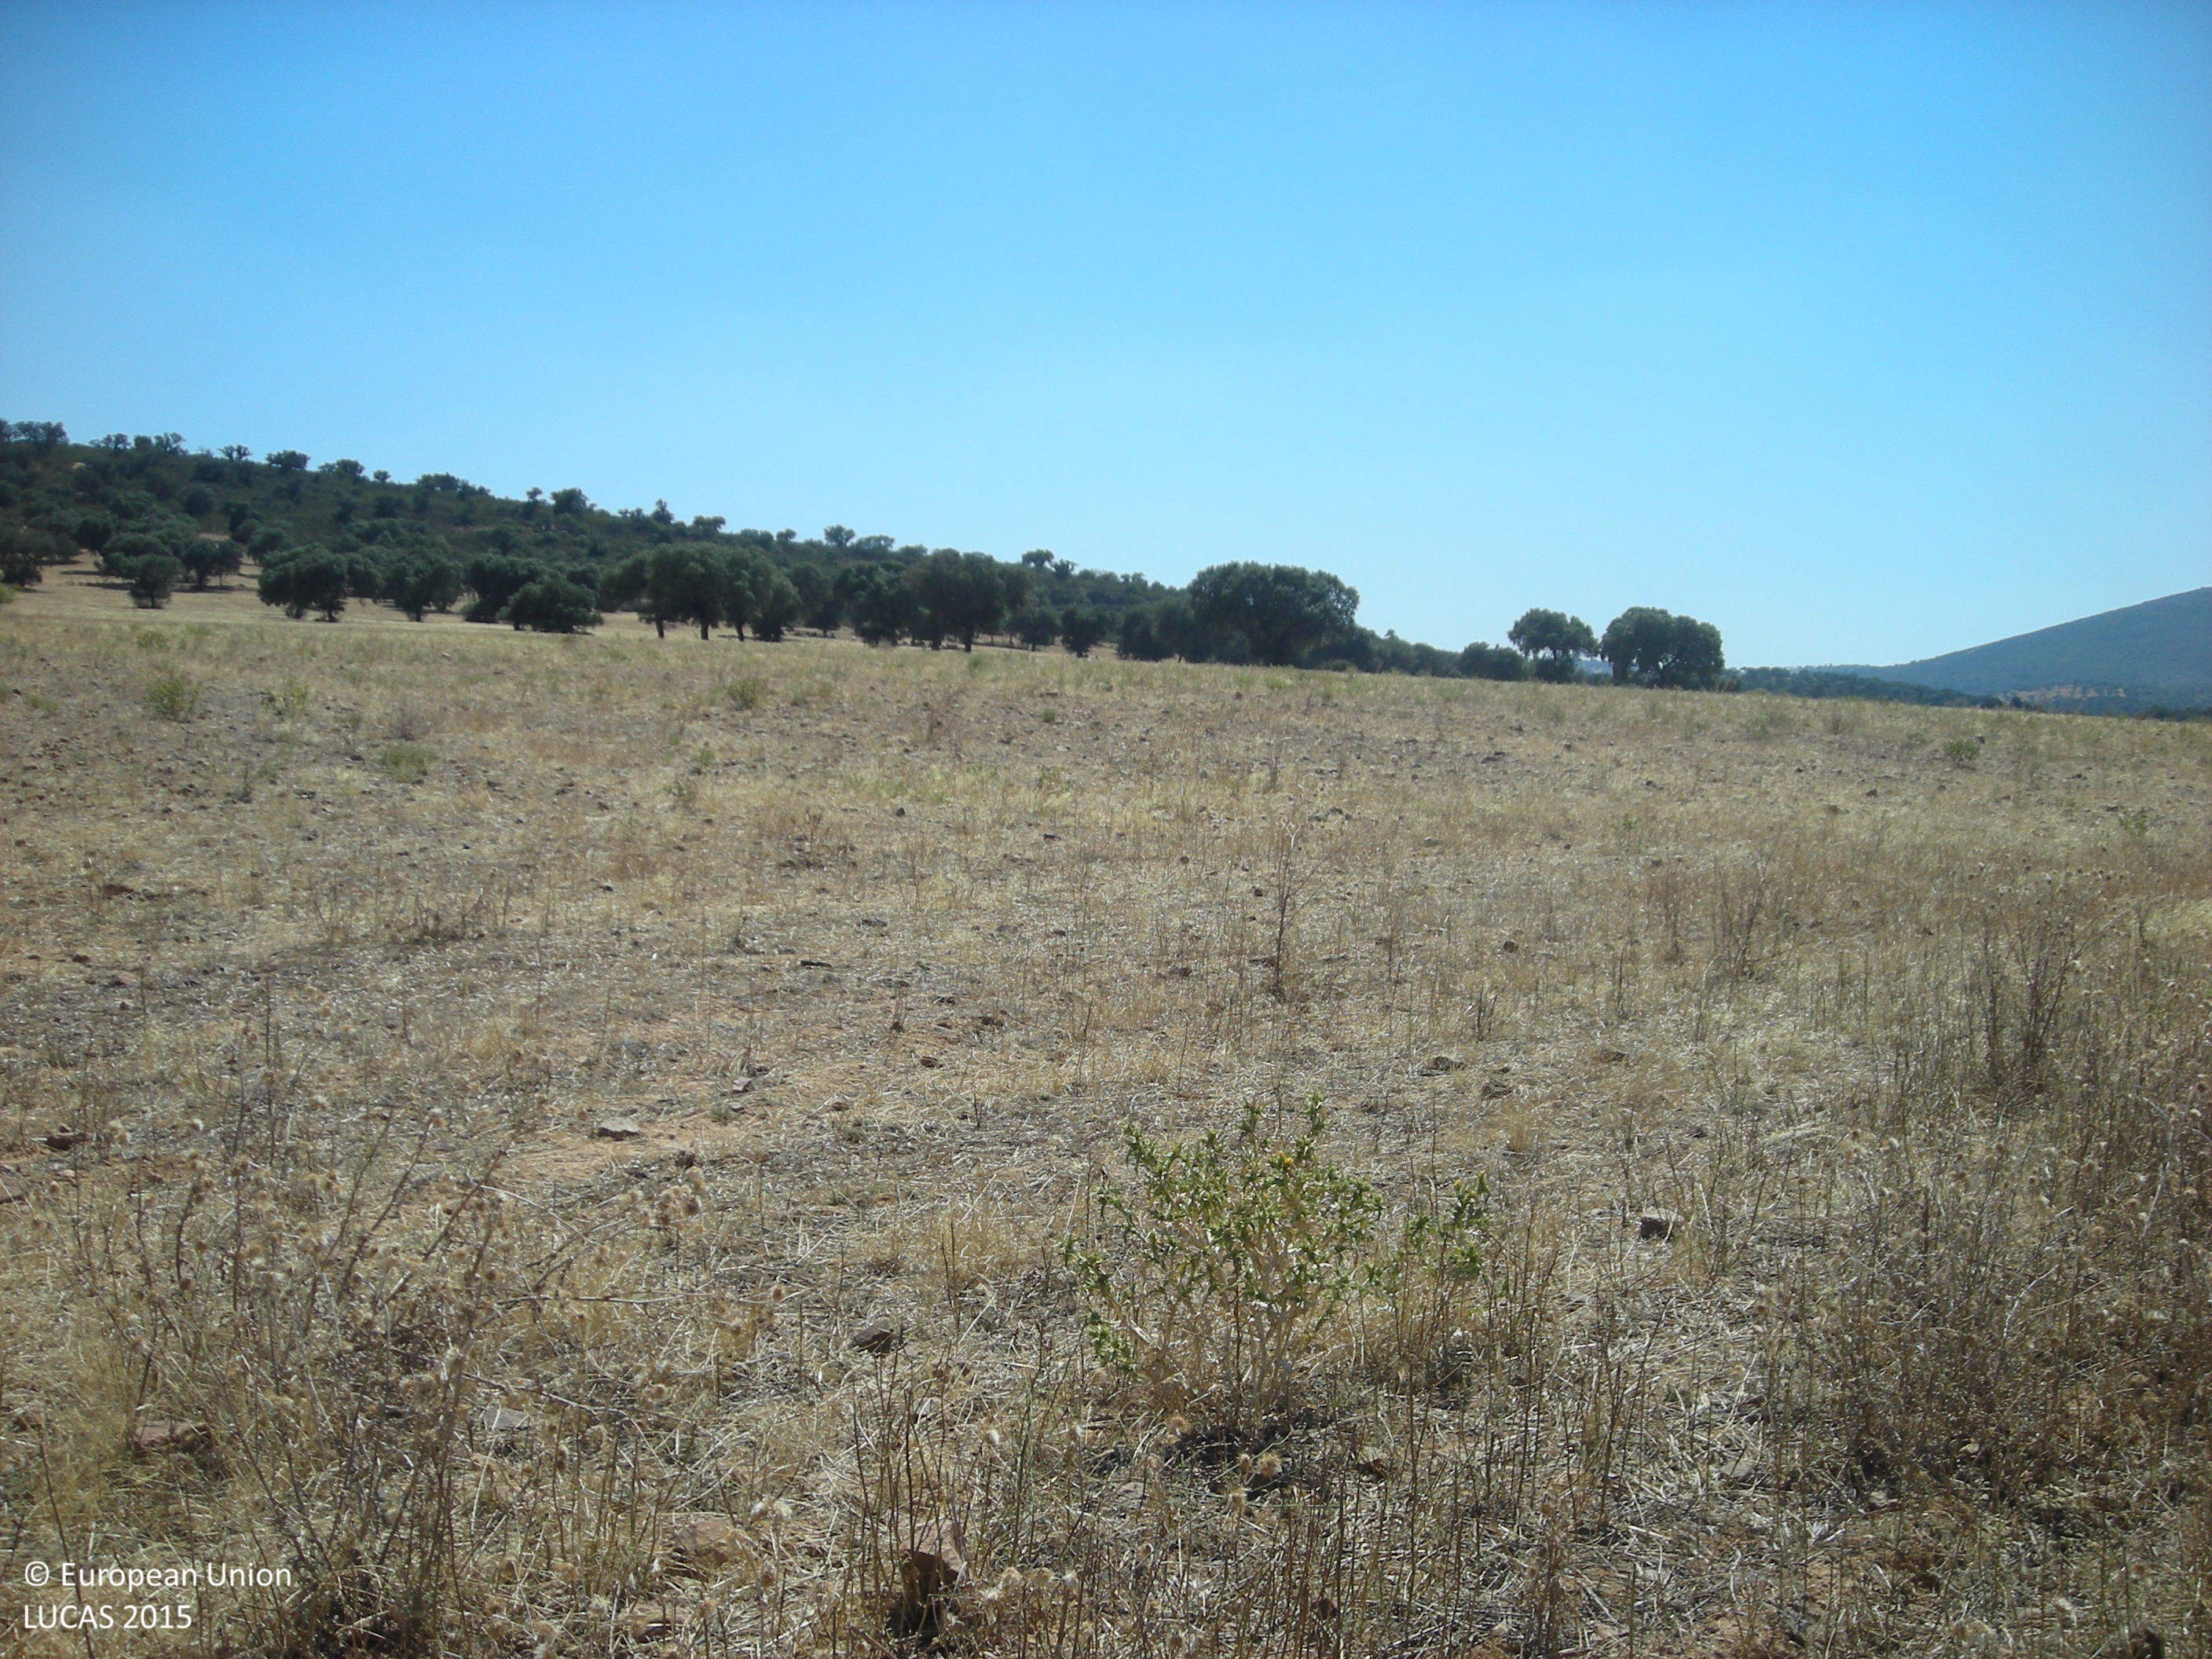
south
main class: Woodland
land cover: Broadleaved woodland
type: broadleaved evergreen forest
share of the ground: 25 - 50 %
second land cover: Grassland without tree/shrub cover
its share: 50 - 75 %
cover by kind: herbaceous plants 60 %, broadleaved forest trees 40 %
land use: Forestry
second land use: Agriculture (excluding fallow land and kitchen gardens)
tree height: > 5 m
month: June
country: ES
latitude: 38.6297
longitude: -5.7913
